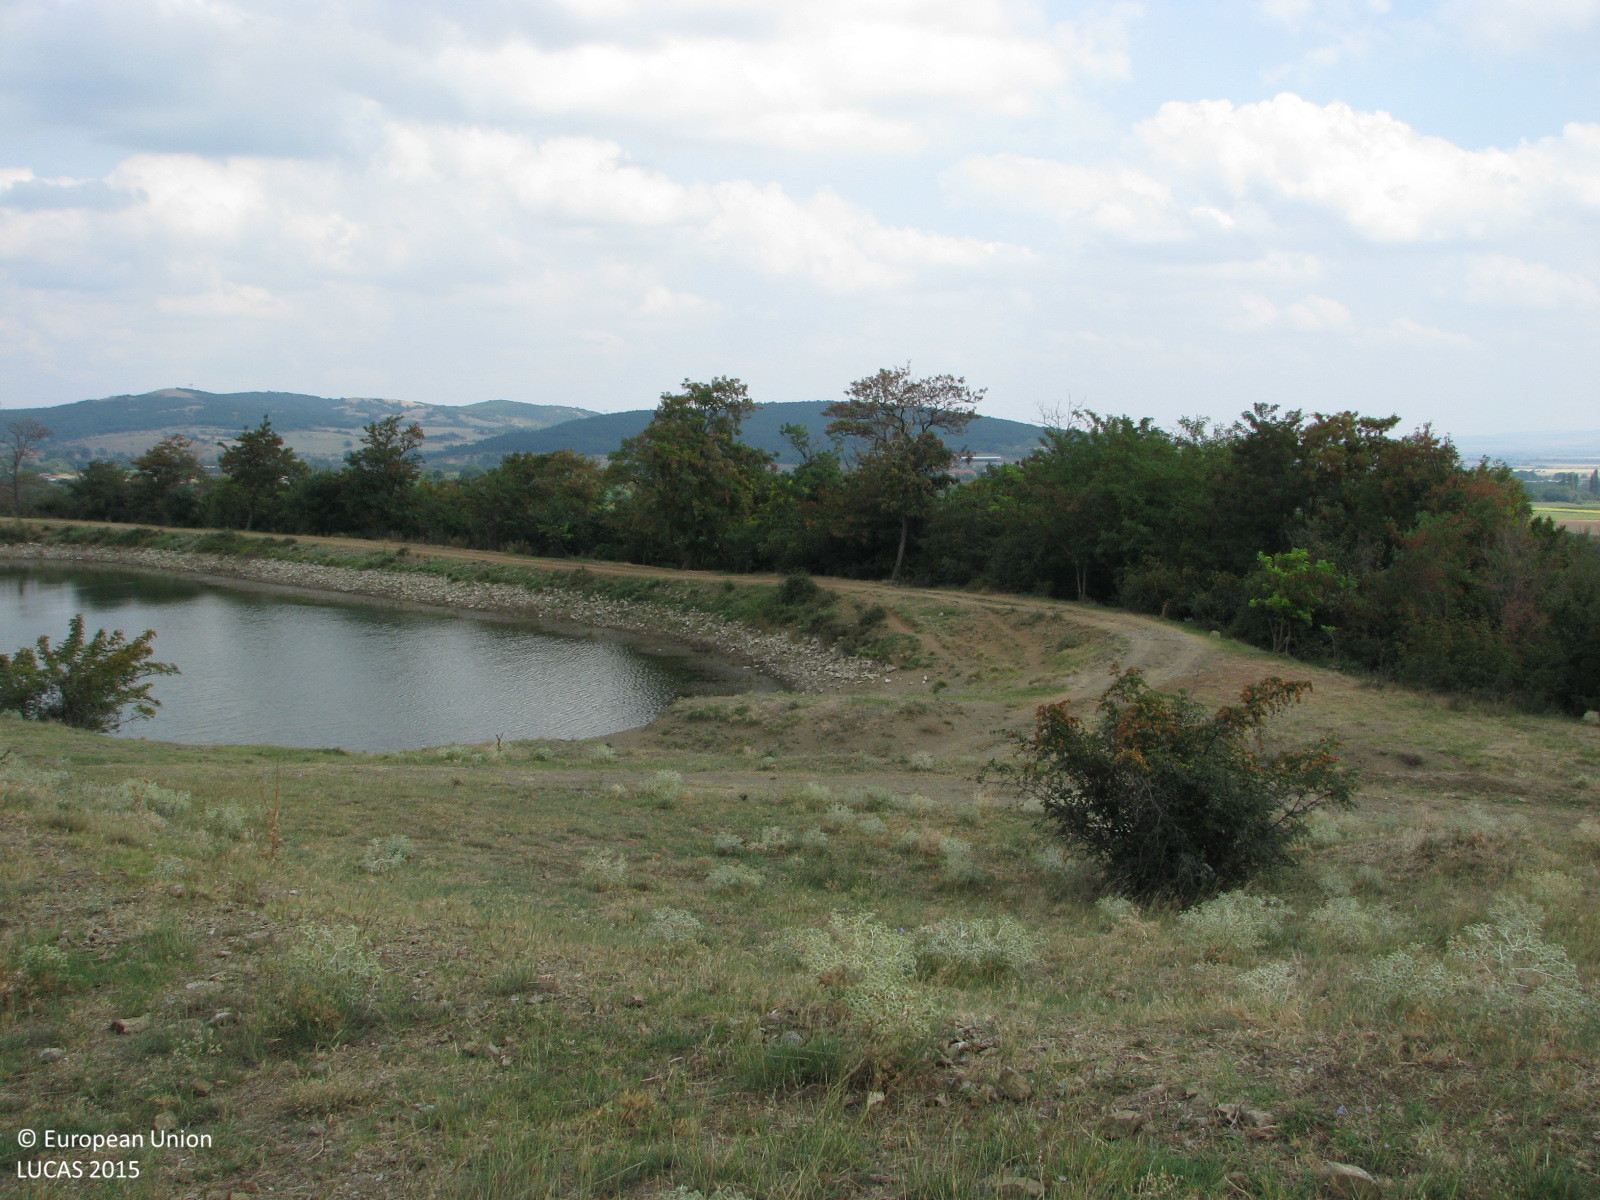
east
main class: Grassland
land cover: Grassland with sparse tree/shrub cover
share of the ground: > 75 %
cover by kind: herbaceous plants 85 %, shrubs 10 %, broadleaved forest trees 5 %
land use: Agriculture (excluding fallow land and kitchen gardens)
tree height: < 5 m
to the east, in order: Grassland with sparse tree/shrub cover; Tracks; Grassland with sparse tree/shrub cover; Other bare soil; Inland fresh water bodies; Other bare soil; Grass margins; Tracks; Broadleaved woodland; Fences; Cherry fruit
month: August
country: BG
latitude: 42.5525
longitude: 25.9741
